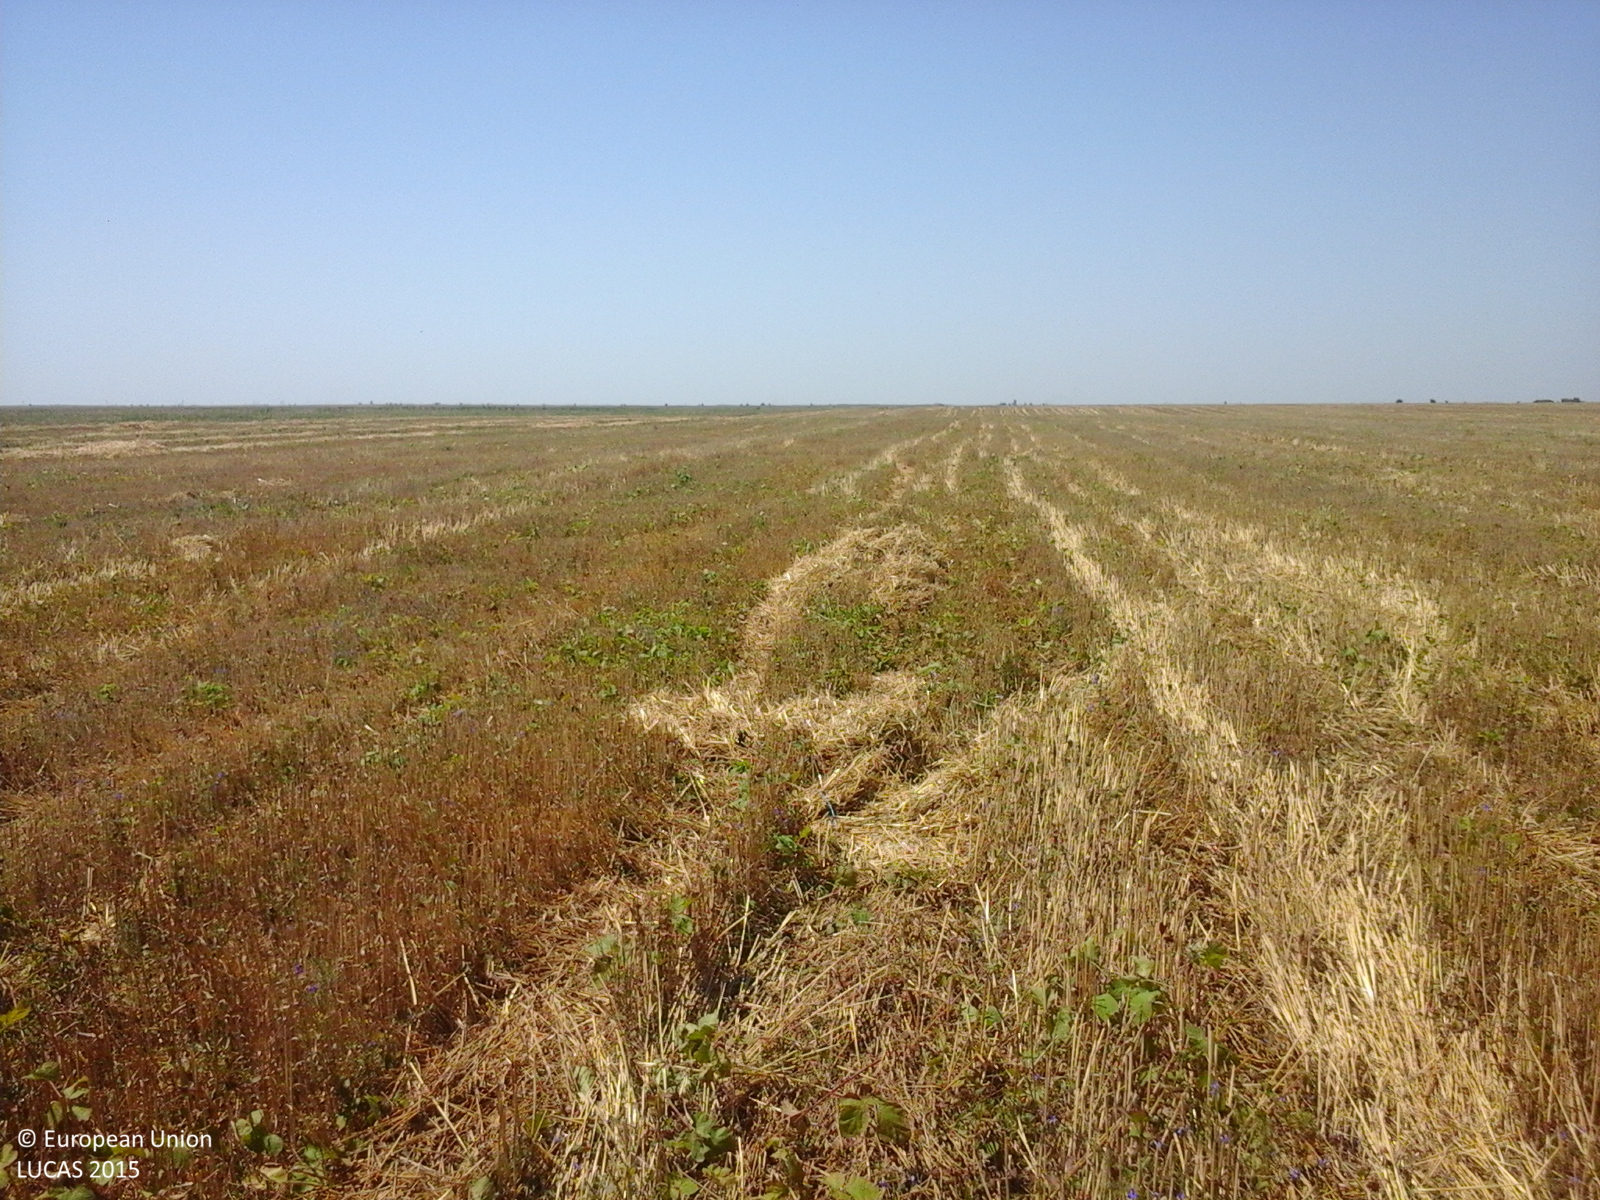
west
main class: Cropland
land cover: Durum wheat
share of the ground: 10 - 25 %
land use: Agriculture (excluding fallow land and kitchen gardens)
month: July
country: RO
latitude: 44.2762
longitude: 26.5657
